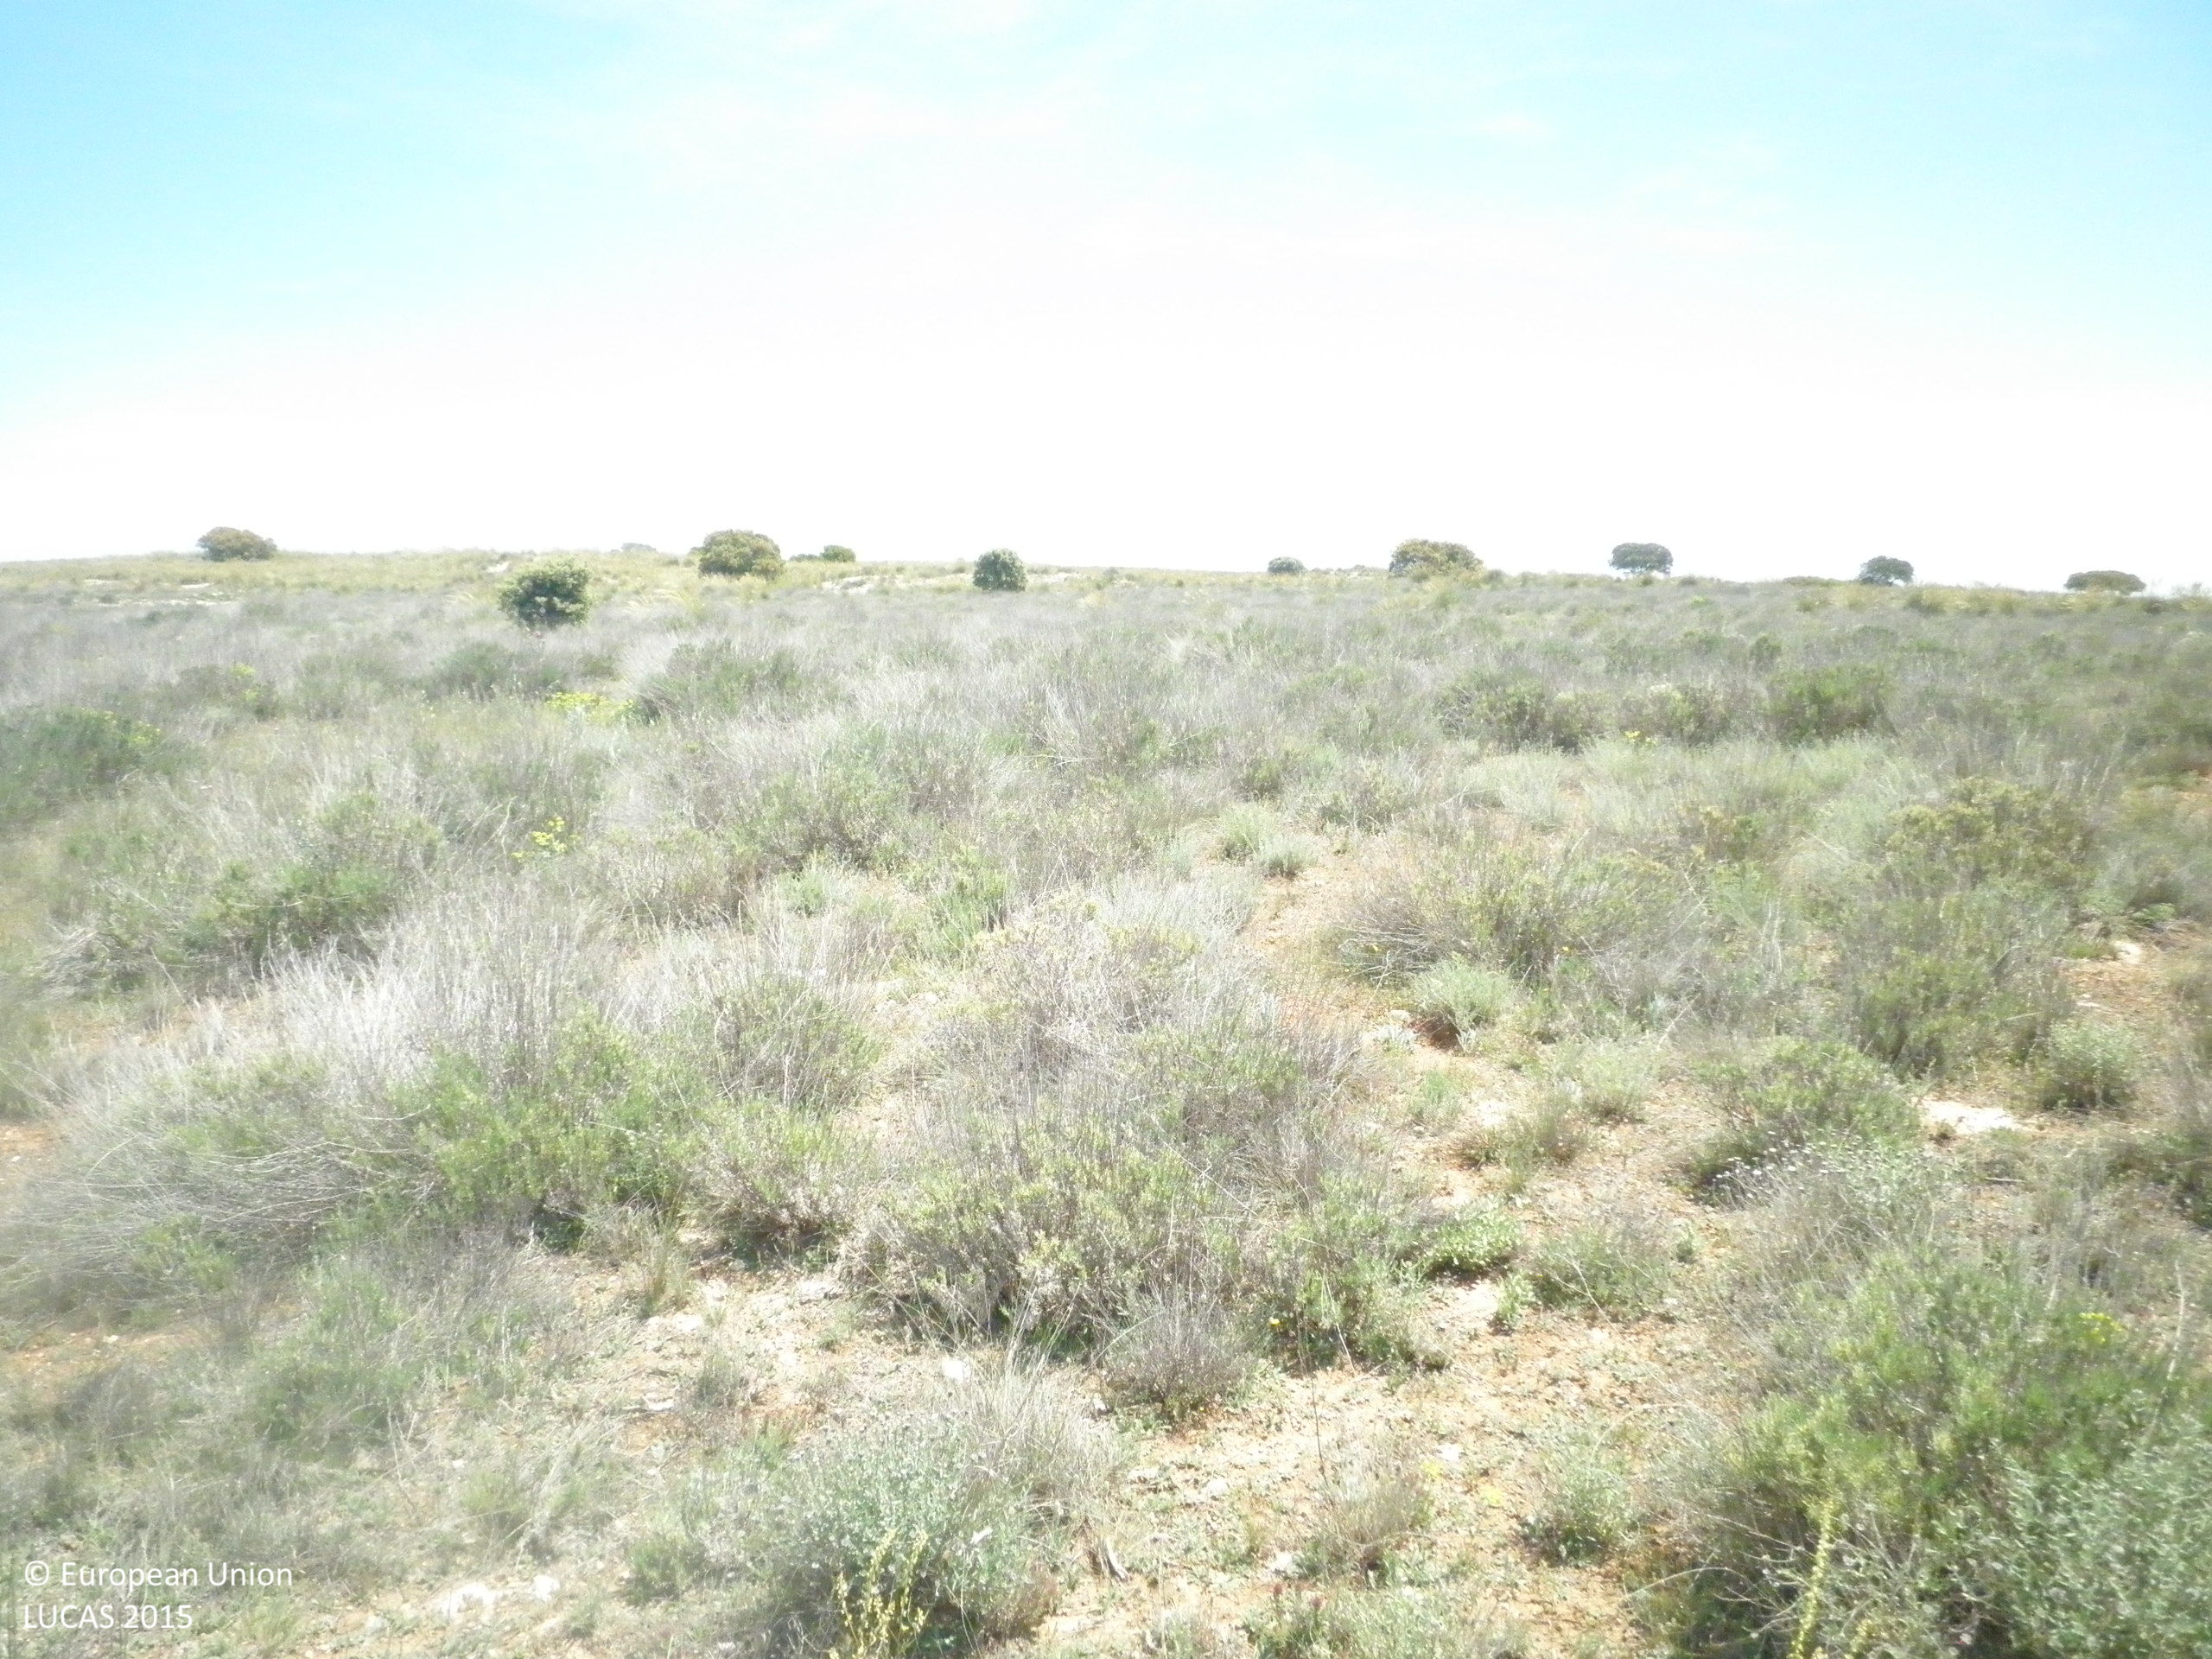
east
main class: Shrubland
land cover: Shrubland without tree cover
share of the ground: 50 - 75 %
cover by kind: unconsolidated bare surface 40 %, shrubs 30 %, herbaceous plants 30 %
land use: Semi-natural and natural areas not in use
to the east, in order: Shrubland without tree cover
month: May
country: ES
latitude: 39.6181
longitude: -2.7245
